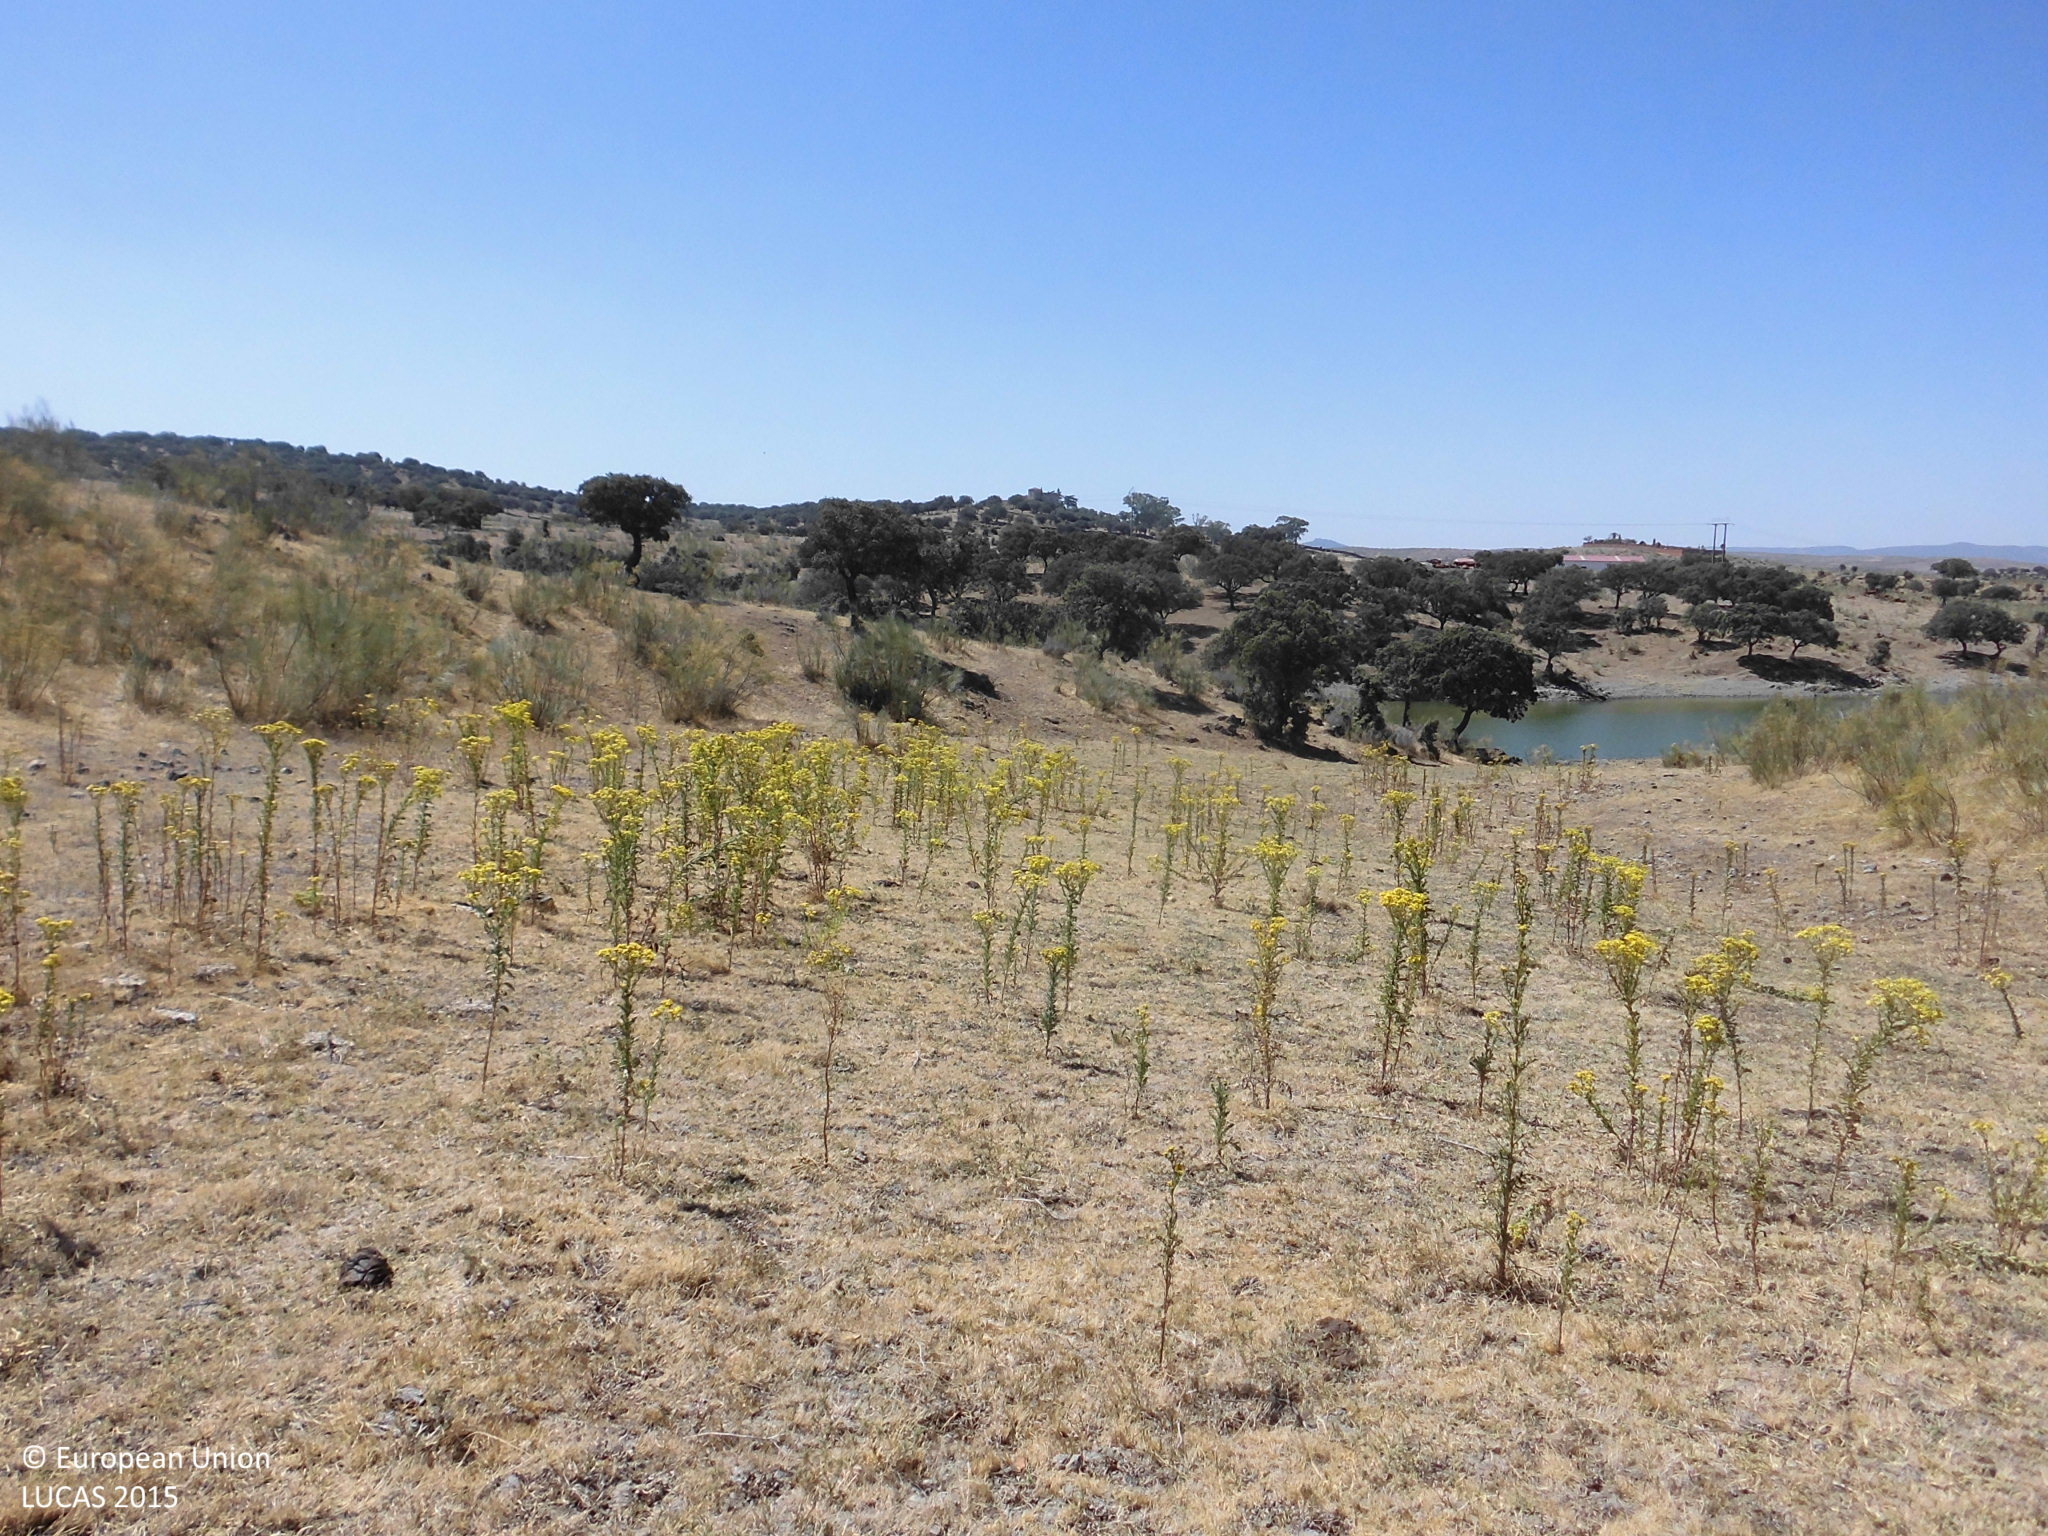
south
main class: Woodland
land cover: Broadleaved woodland
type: broadleaved evergreen forest
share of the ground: 10 - 25 %
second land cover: Grassland without tree/shrub cover
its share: > 75 %
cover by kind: herbaceous plants 85 %, broadleaved forest trees 10 %, shrubs 5 %
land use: Forestry
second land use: Agriculture (excluding fallow land and kitchen gardens)
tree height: > 5 m
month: July
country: ES
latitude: 39.9752
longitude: -6.2200
